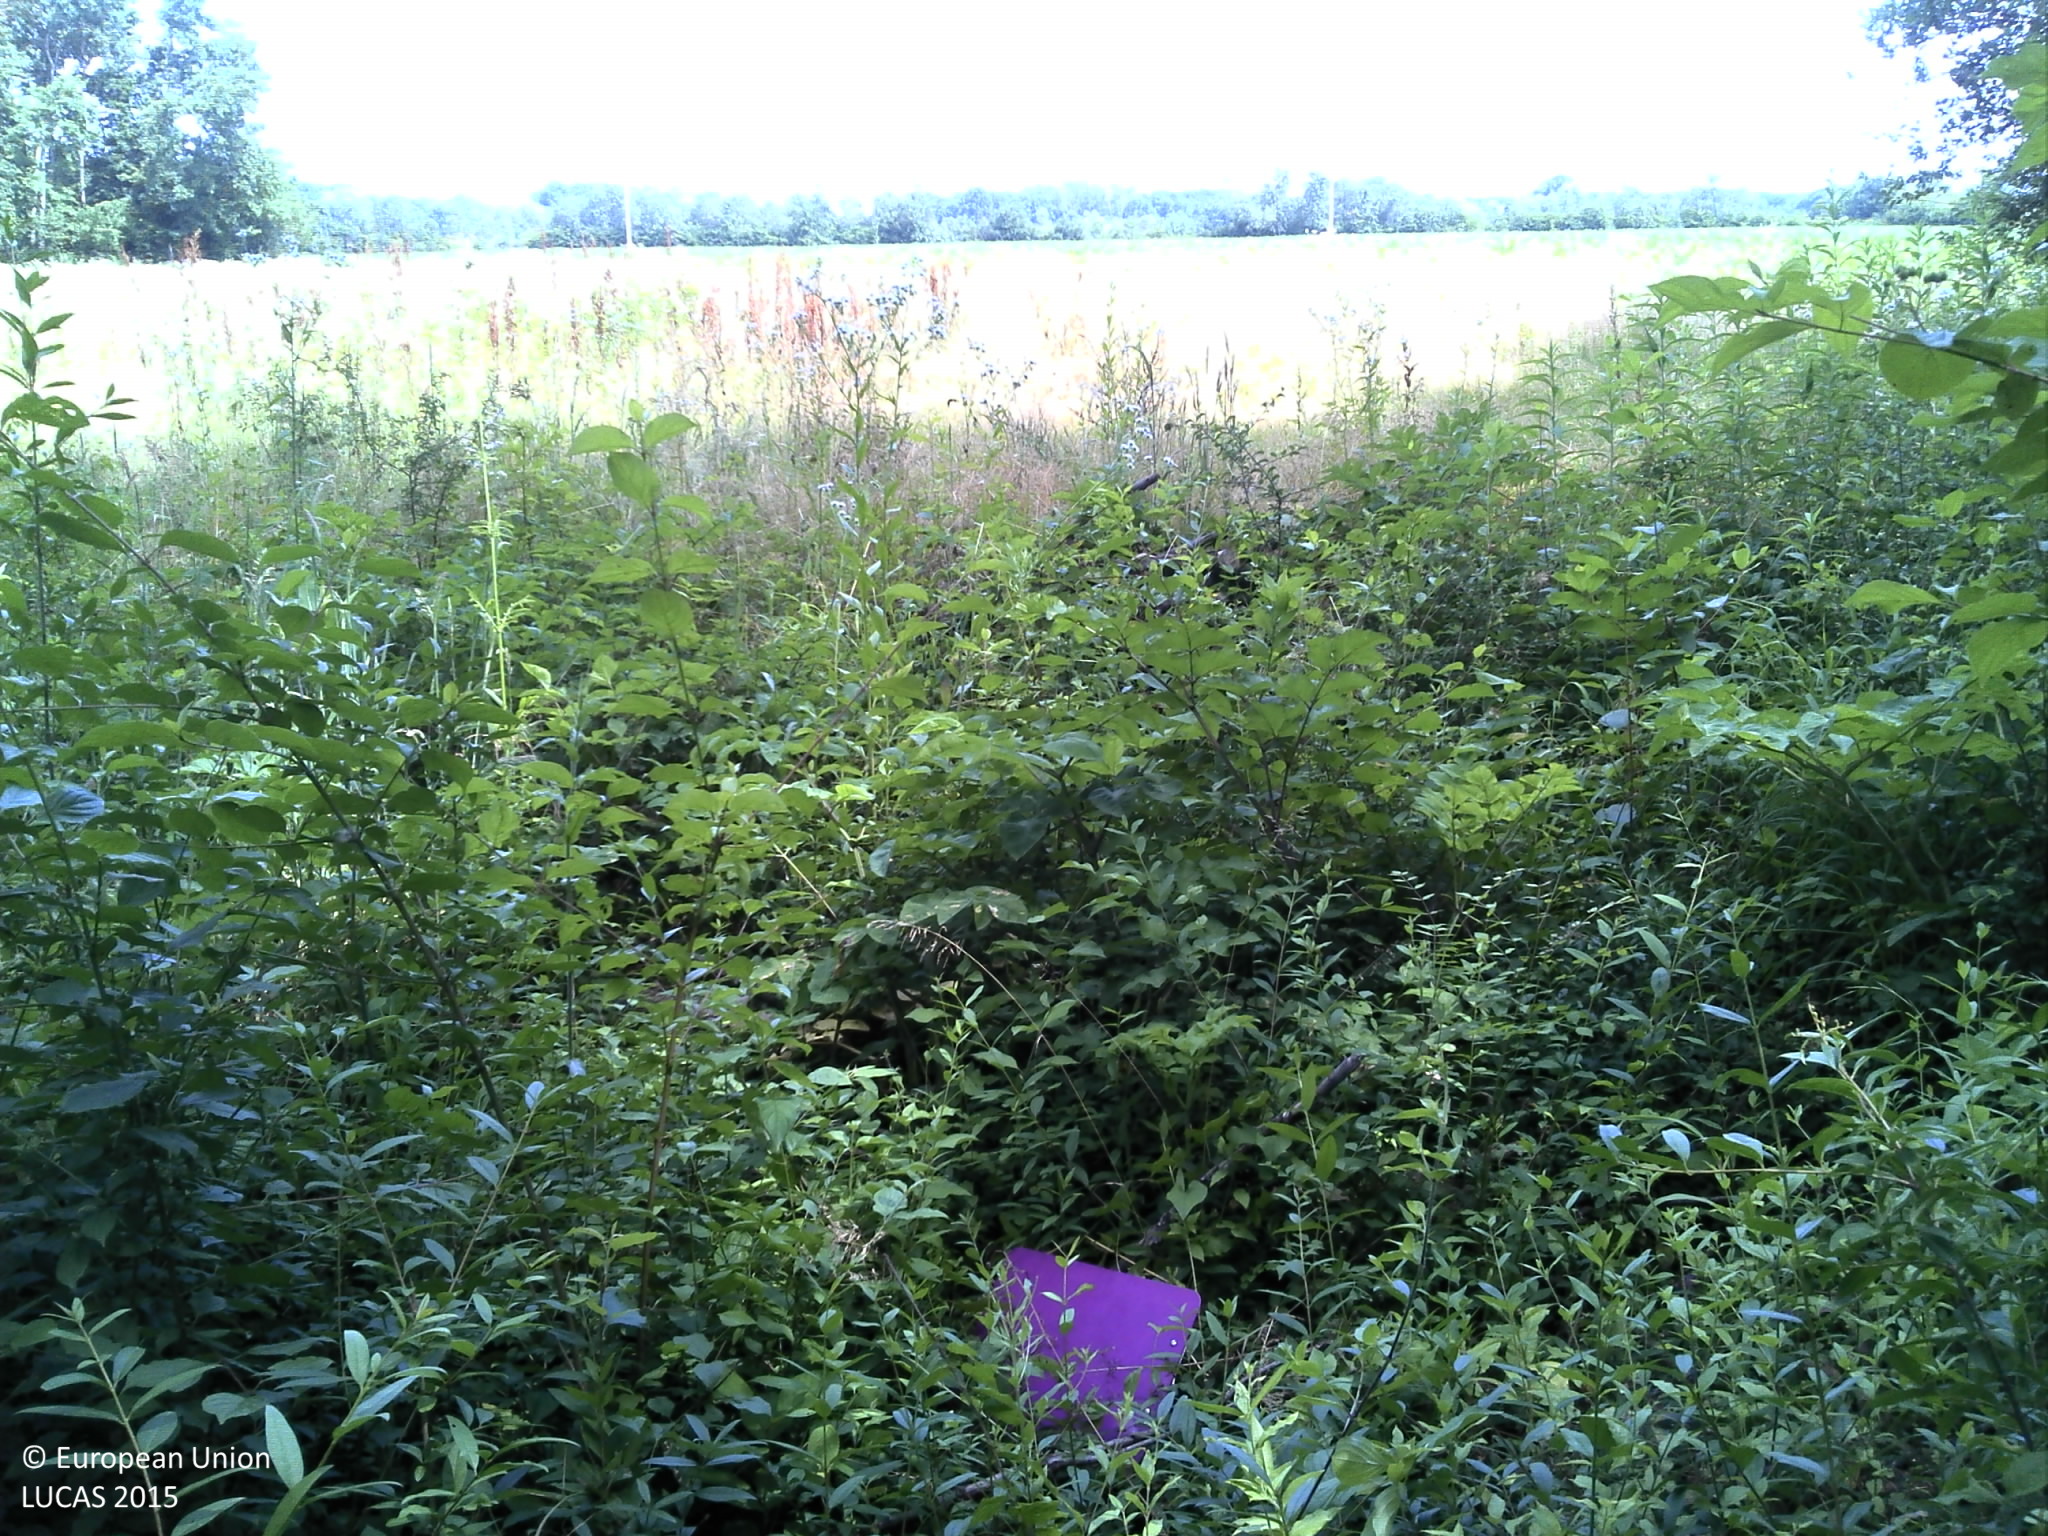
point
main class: Woodland
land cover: Broadleaved woodland
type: acidophilous oak and oak-birch forest
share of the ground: 50 - 75 %
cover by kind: broadleaved forest trees 75 %, shrubs 25 %
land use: Forestry
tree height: > 5 m
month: June
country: HR
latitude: 45.1019
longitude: 17.8680
